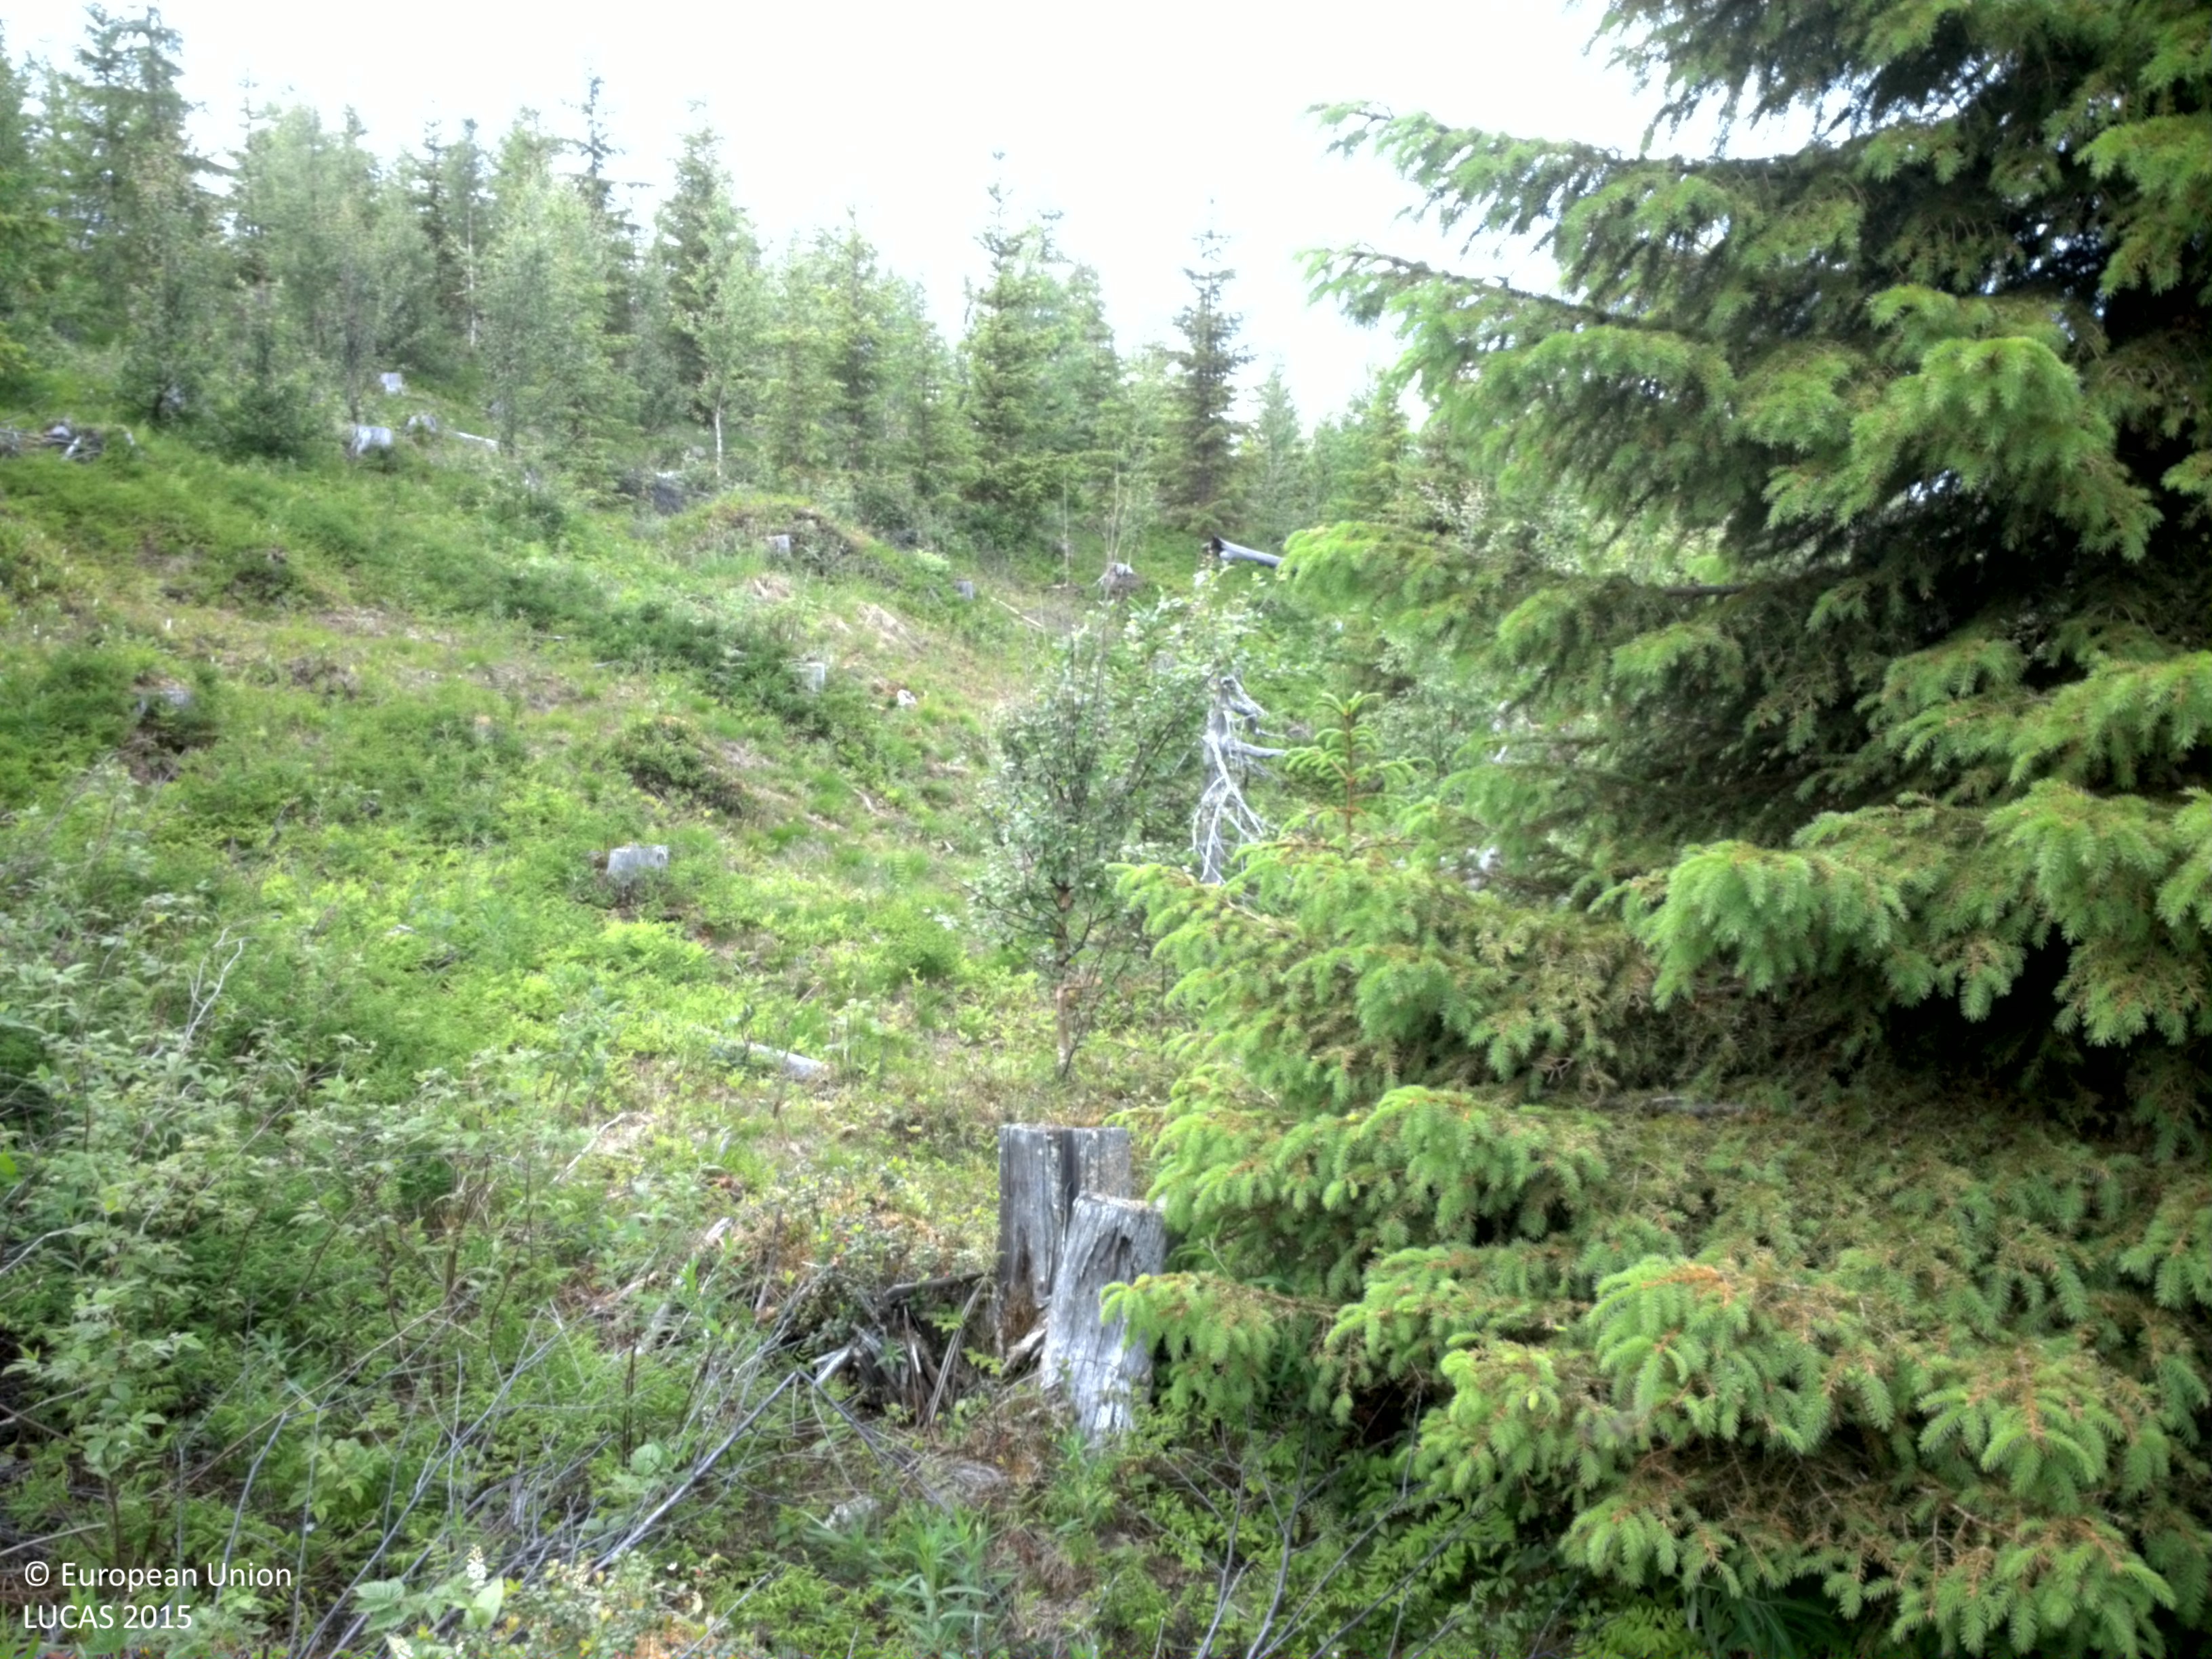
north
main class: Woodland
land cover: Spruce dominated mixed woodland
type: boreal forest
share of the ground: 50 - 75 %
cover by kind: coniferous forest trees 45 %, herbaceous plants 20 %, broadleaved forest trees 15 %, shrubs 15 %, lichens and mosses 5 %
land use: Forestry
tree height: > 5 m
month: July
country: SE
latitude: 64.5375
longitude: 18.0768
